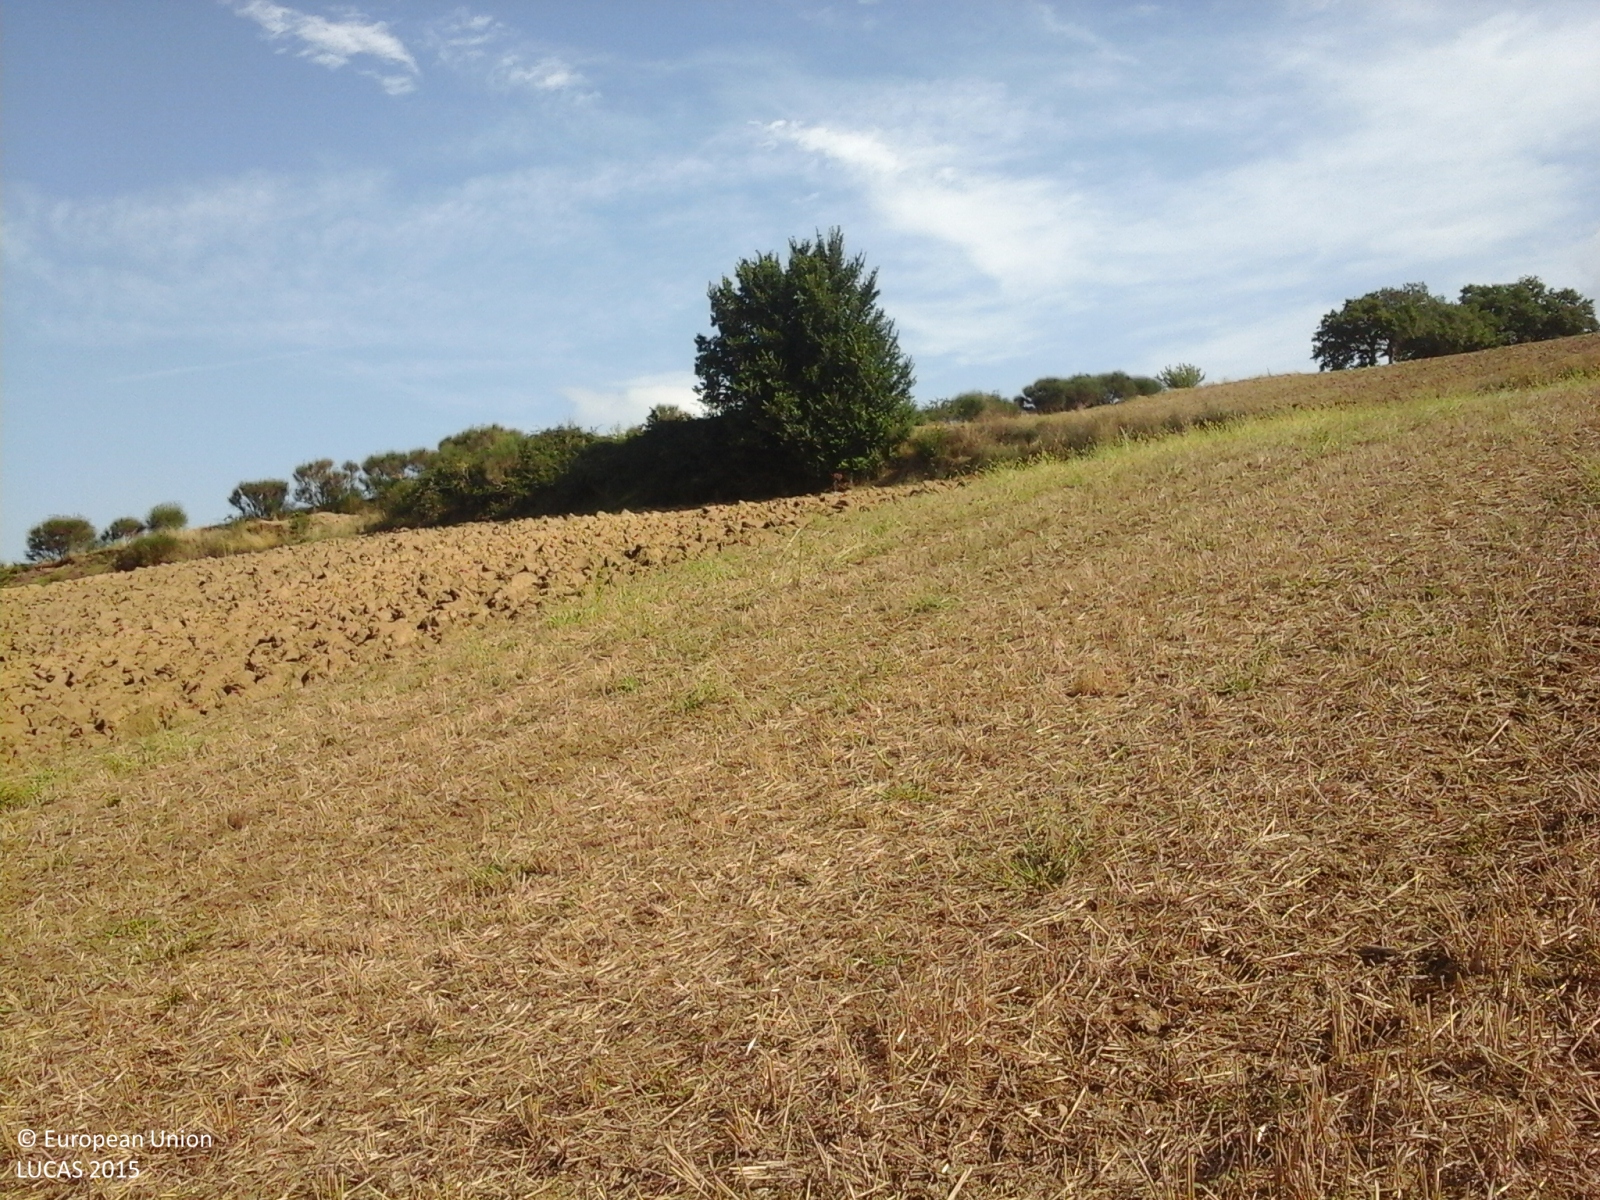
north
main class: Cropland
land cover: Durum wheat
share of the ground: < 10 %
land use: Agriculture (excluding fallow land and kitchen gardens)
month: August
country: IT
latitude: 43.3274
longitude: 13.1612
